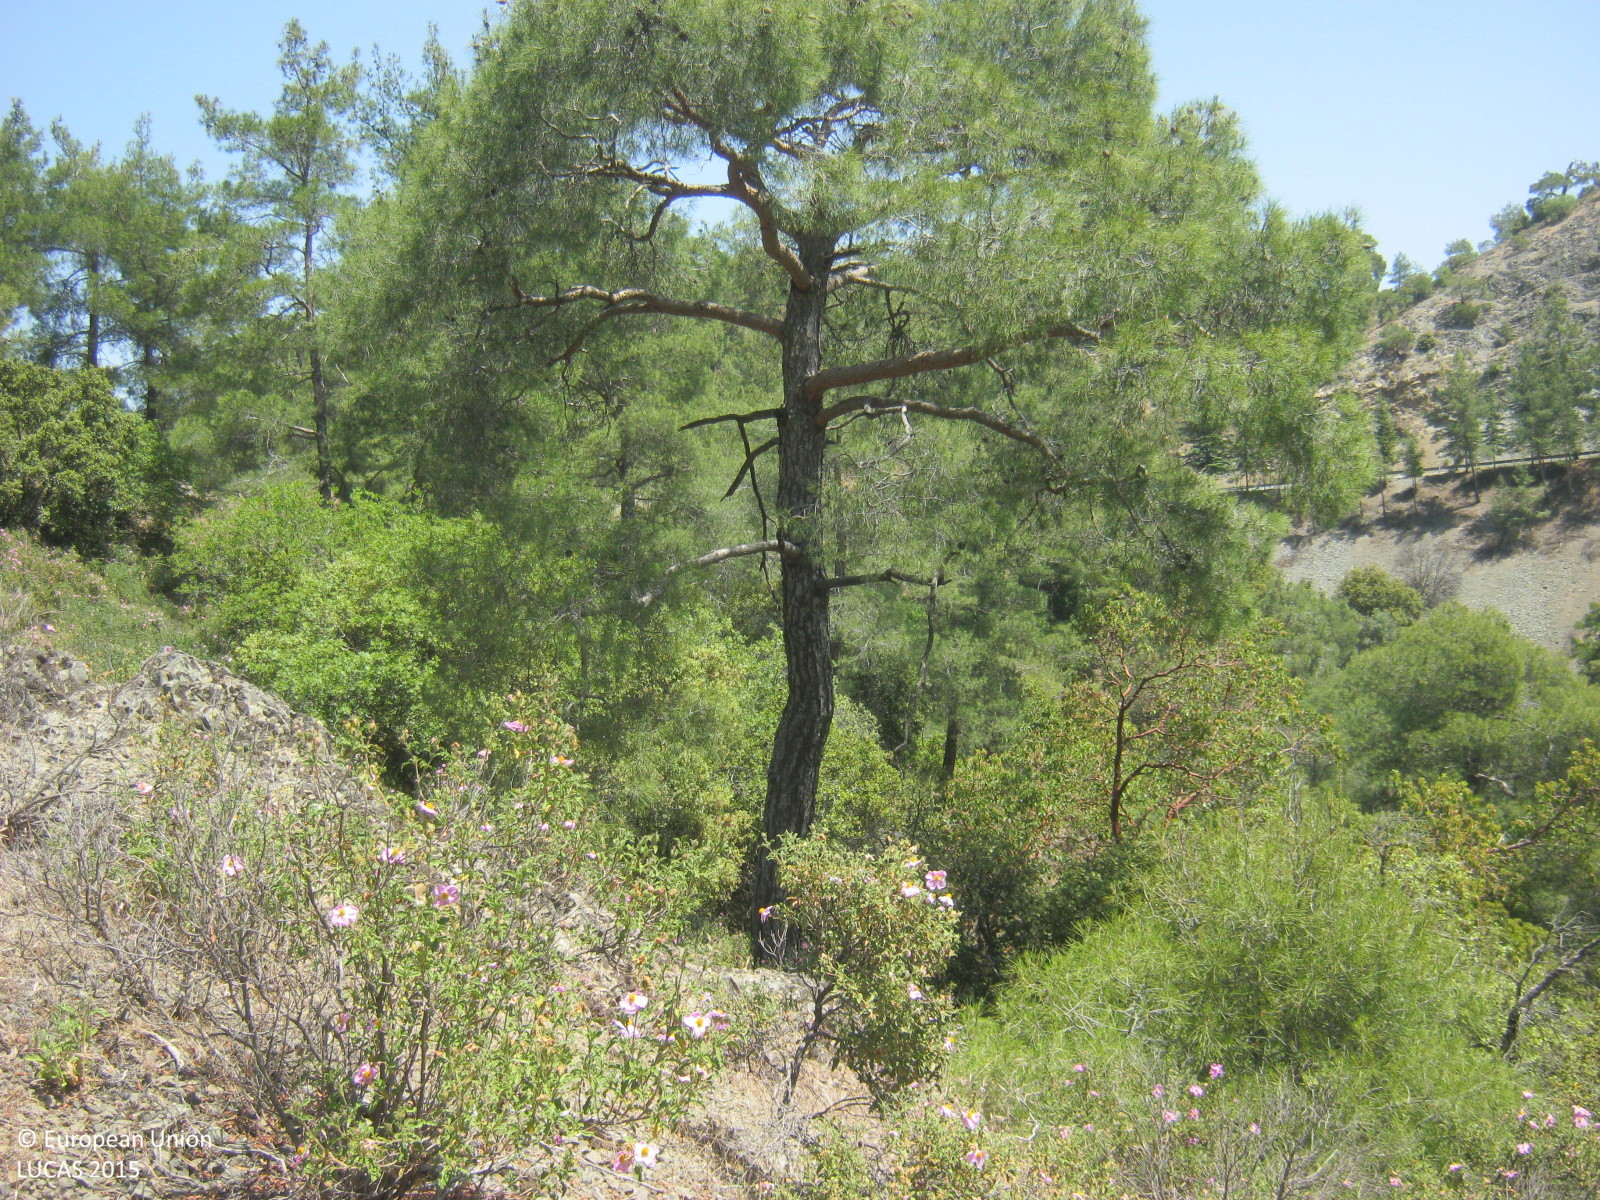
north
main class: Woodland
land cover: Pine dominated mixed woodland
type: coniferous forest of the mediterranean region
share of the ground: > 75 %
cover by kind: coniferous forest trees 75 %, broadleaved forest trees 25 %
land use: Semi-natural and natural areas not in use
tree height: > 5 m
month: May
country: CY
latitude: 34.9799
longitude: 32.7851
